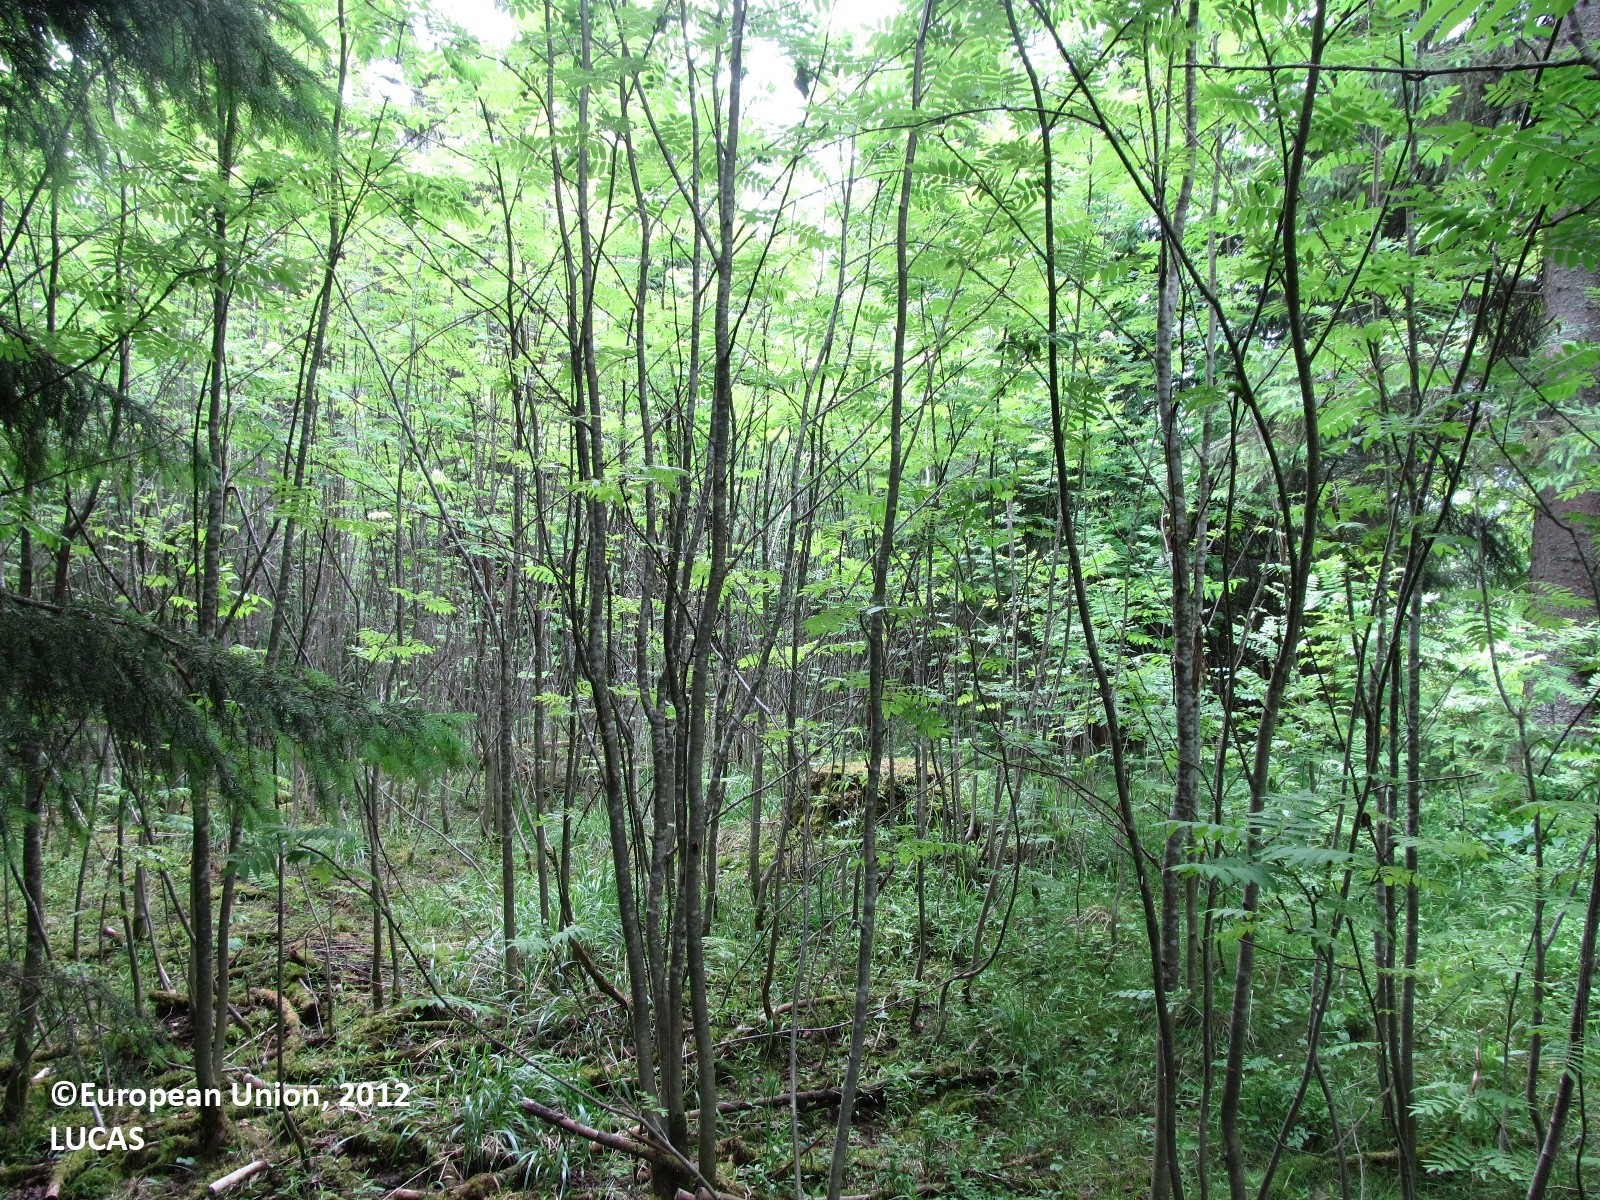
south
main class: Woodland
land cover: Spruce dominated mixed woodland
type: boreal forest
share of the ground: 50 - 75 %
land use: Forestry
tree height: > 5 m
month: June
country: FI
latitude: 63.2143
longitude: 27.7701
